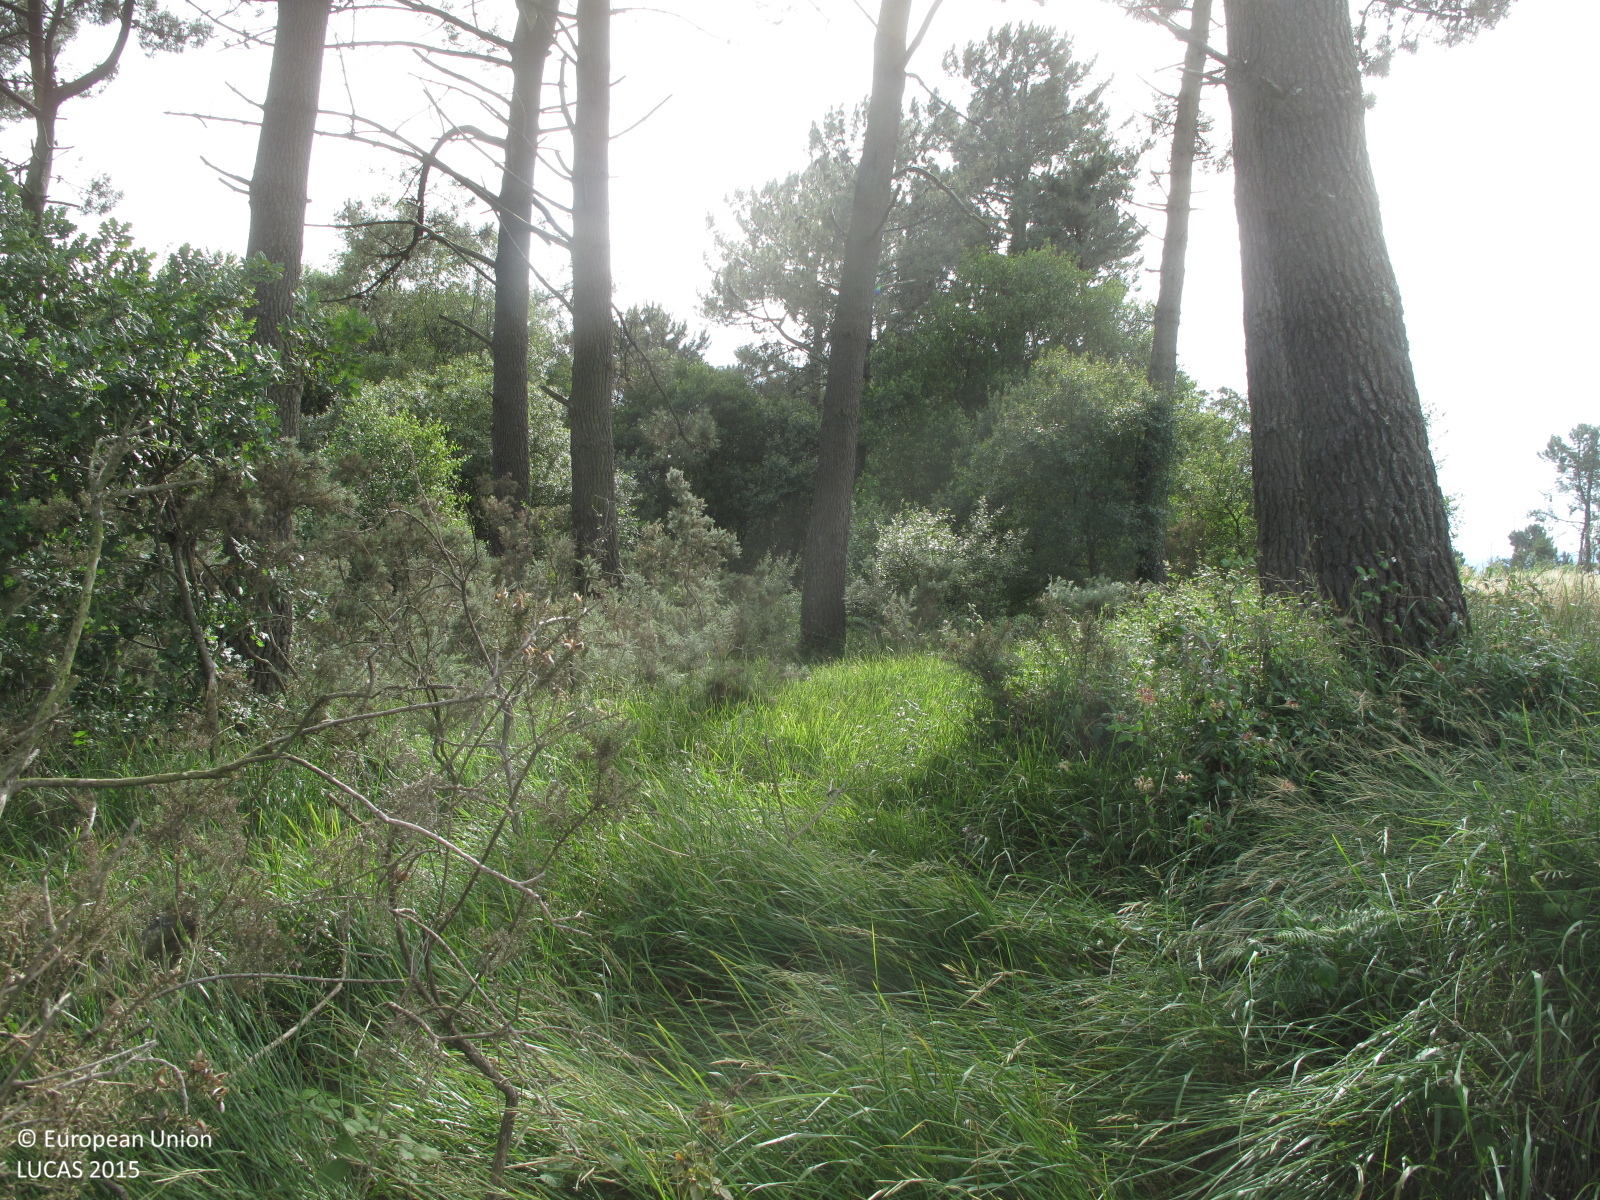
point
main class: Woodland
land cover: Pine dominated mixed woodland
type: exotic forest
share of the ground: 50 - 75 %
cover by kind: coniferous forest trees 40 %, broadleaved forest trees 20 %, shrubs 20 %, herbaceous plants 20 %
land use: Forestry
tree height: > 5 m
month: July
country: ES
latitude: 43.2642
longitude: -8.5781
